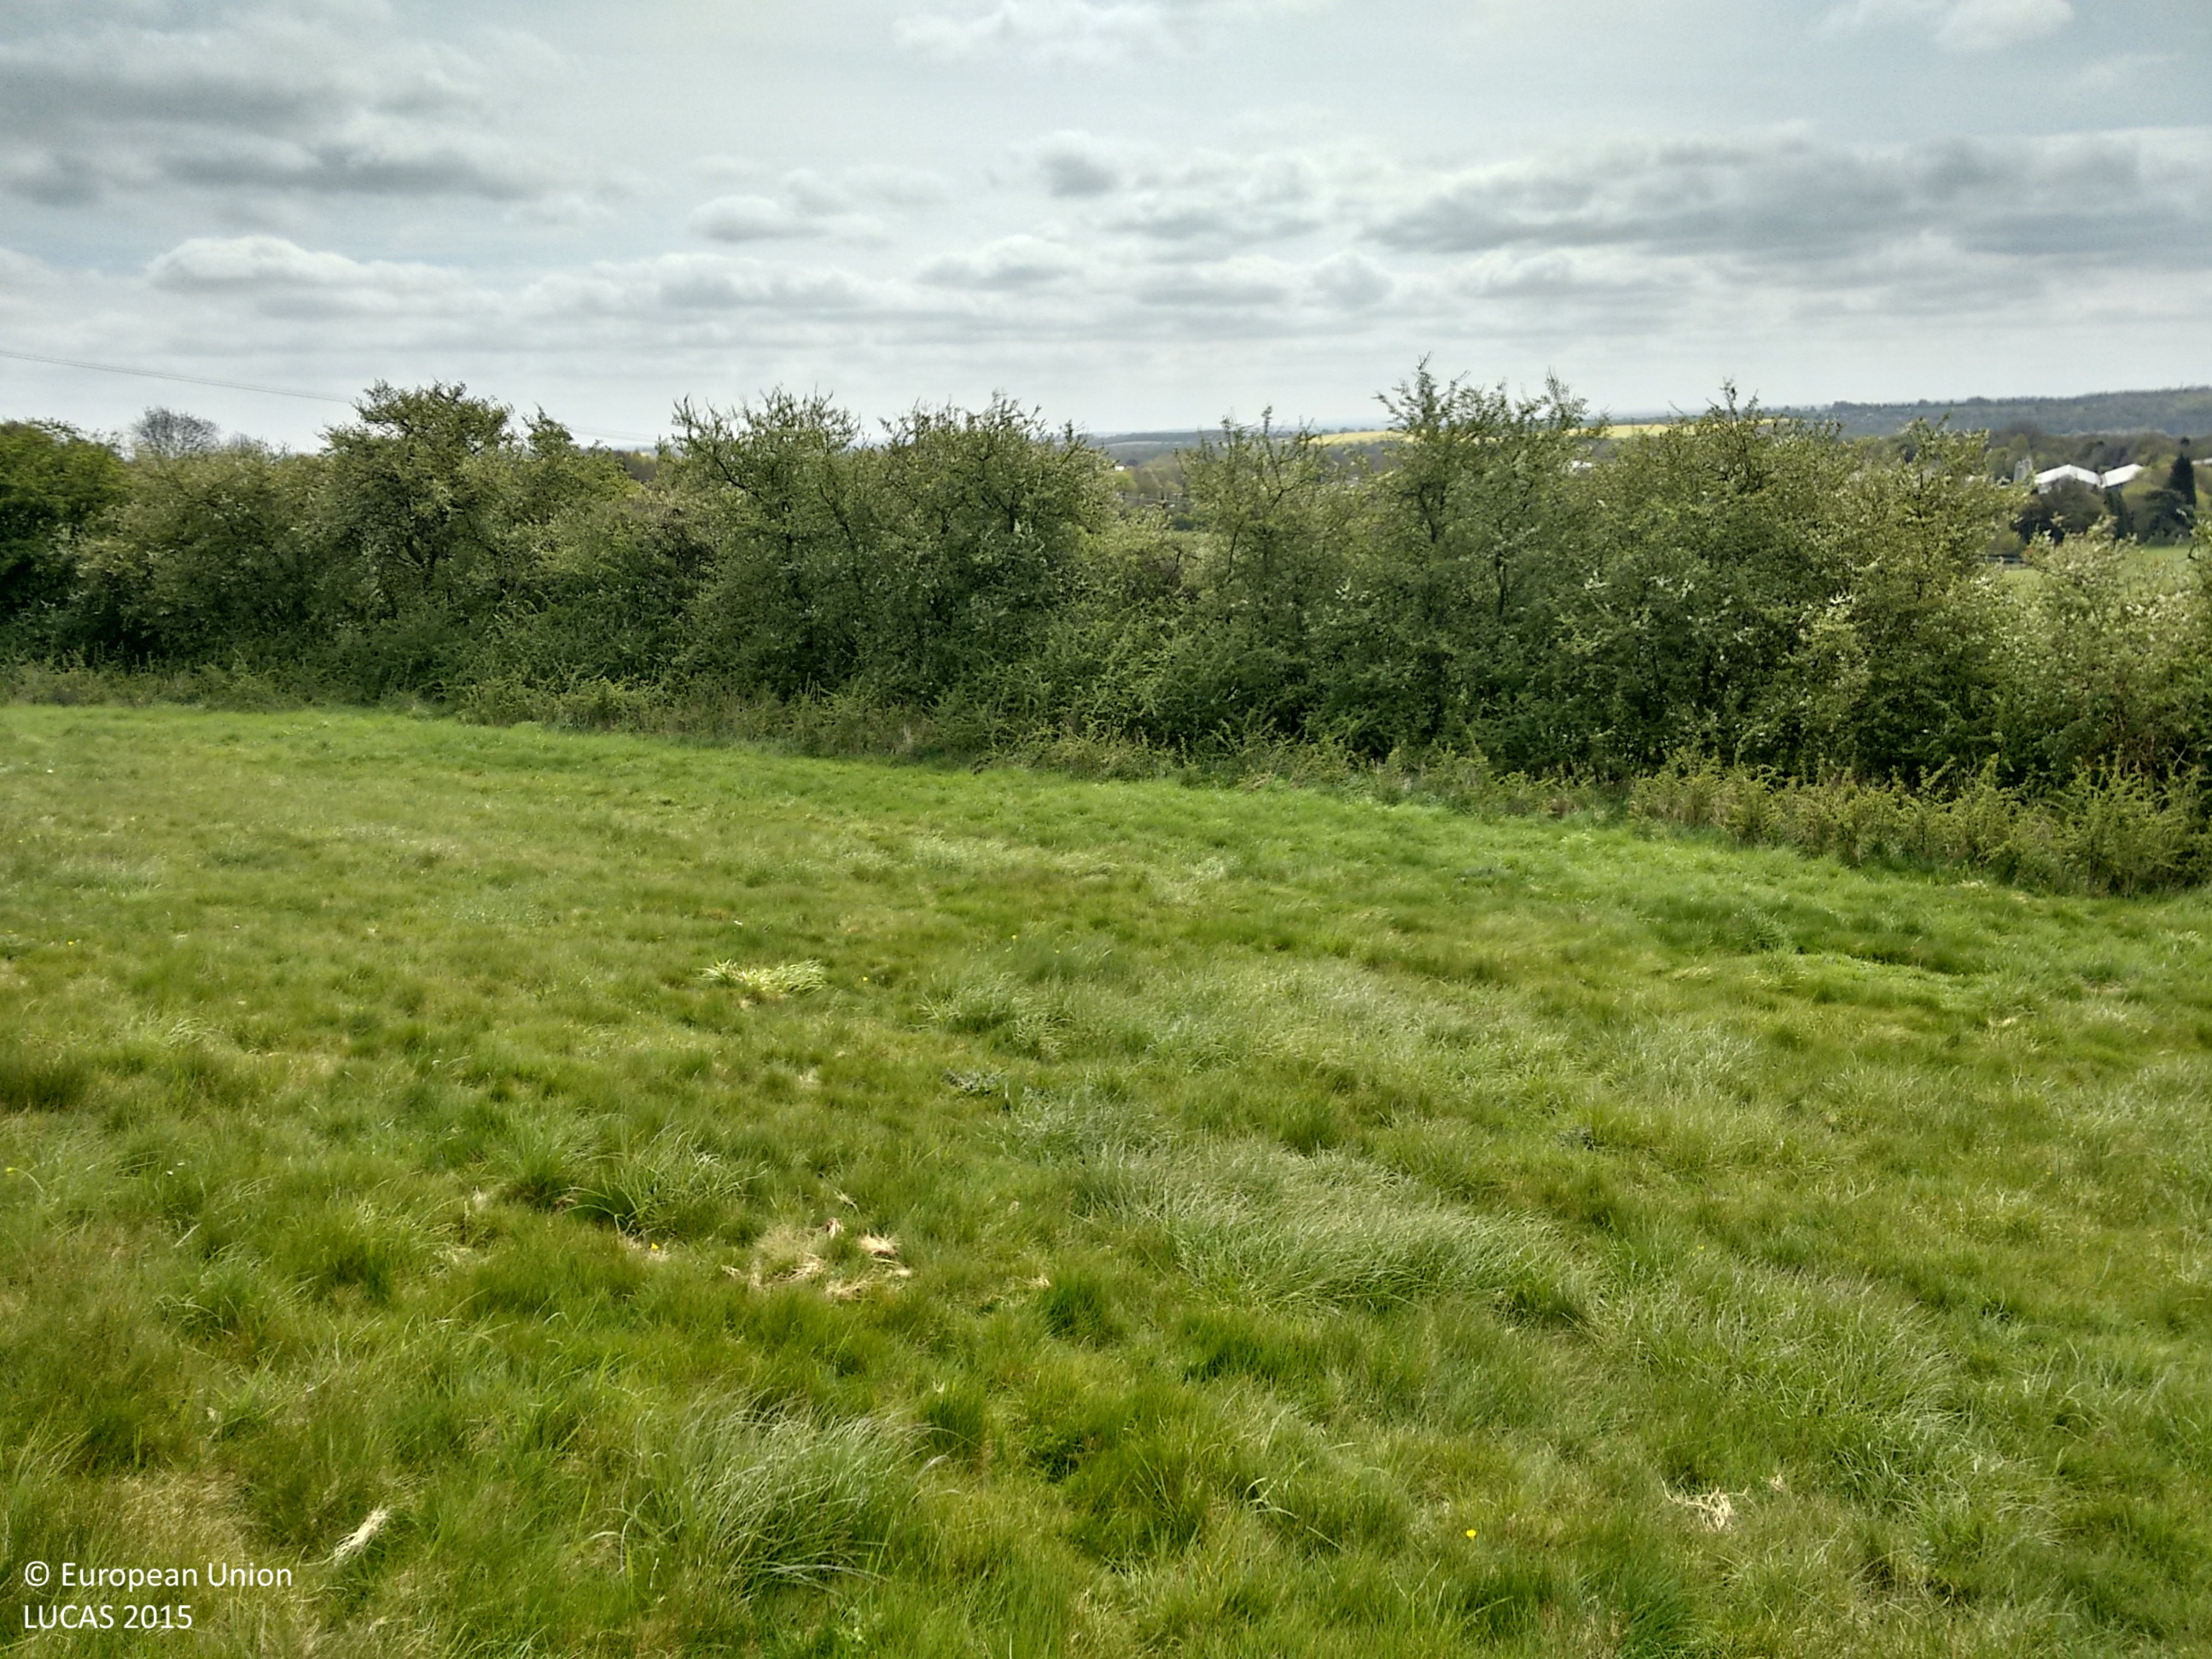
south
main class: Grassland
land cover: Grassland without tree/shrub cover
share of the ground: > 75 %
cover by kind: herbaceous plants 100 %
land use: Semi-natural and natural areas not in use
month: May
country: GB
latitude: 51.2518
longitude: 0.7040
